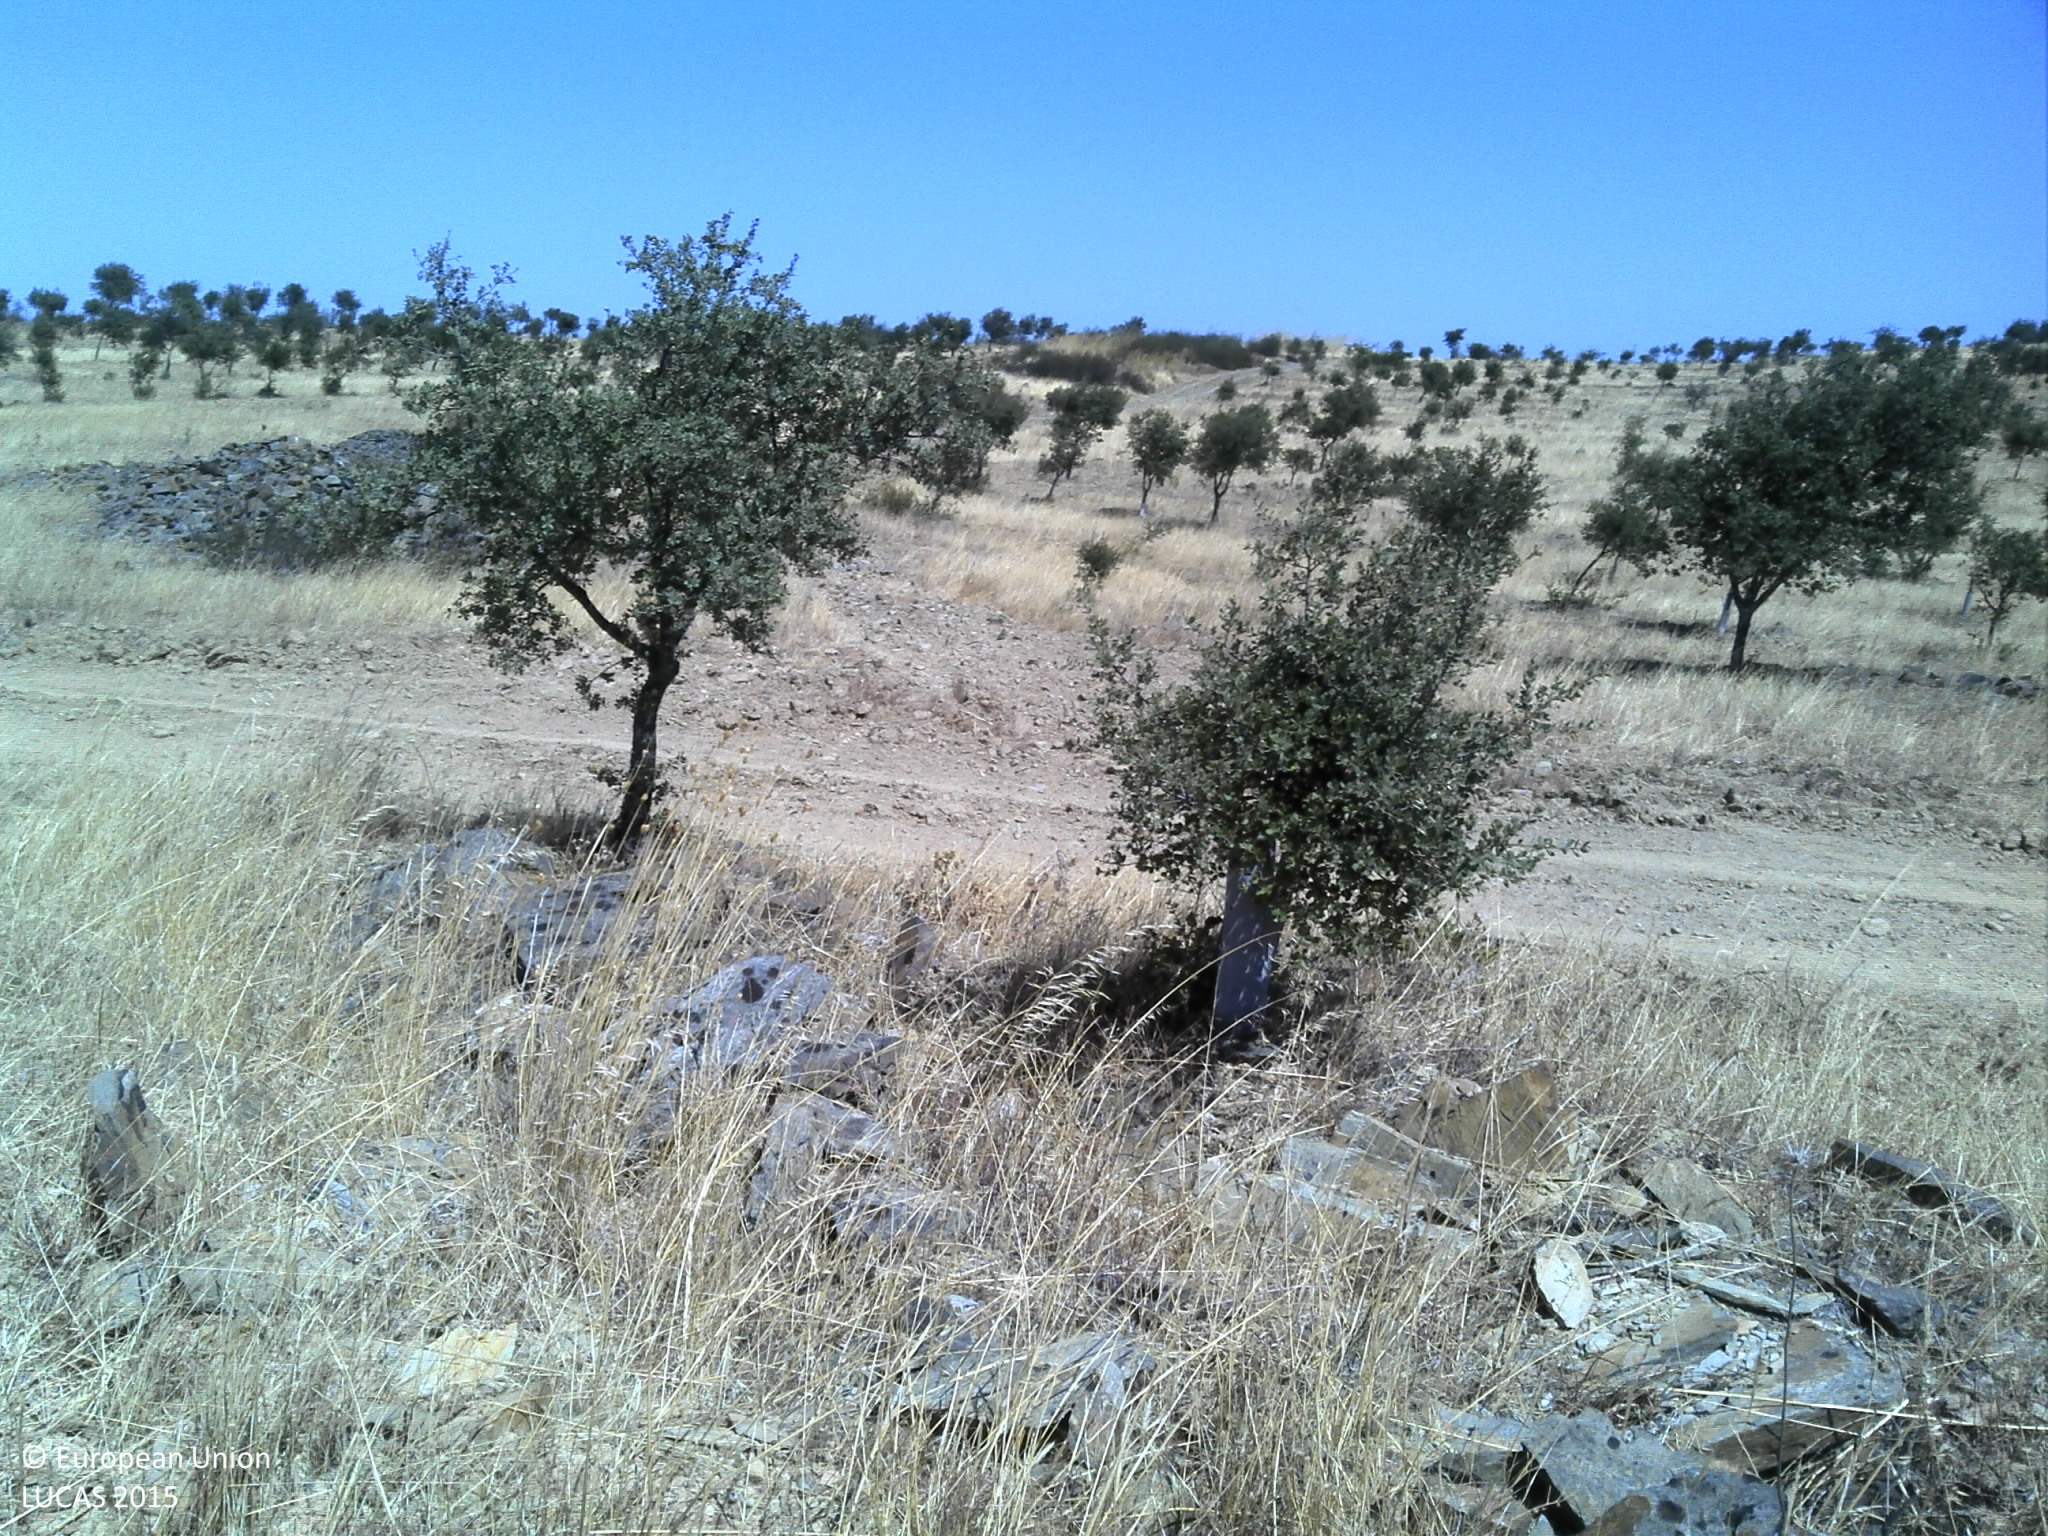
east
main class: Woodland
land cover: Broadleaved woodland
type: broadleaved evergreen forest
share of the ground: 10 - 25 %
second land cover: Grassland without tree/shrub cover
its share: 50 - 75 %
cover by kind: herbaceous plants 60 %, broadleaved forest trees 20 %, unconsolidated bare surface 15 %, consolidated bare surface 5 %
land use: Forestry
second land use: Agriculture (excluding fallow land and kitchen gardens)
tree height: < 5 m
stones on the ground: < 10 %
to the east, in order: Broadleaved woodland; Grassland without tree/shrub cover; Tracks; Rocks and stones; Other structural elements; Grassland without tree/shrub cover; Broadleaved woodland; Grassland without tree/shrub cover
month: July
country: PT
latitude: 37.6329
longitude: -7.9602
